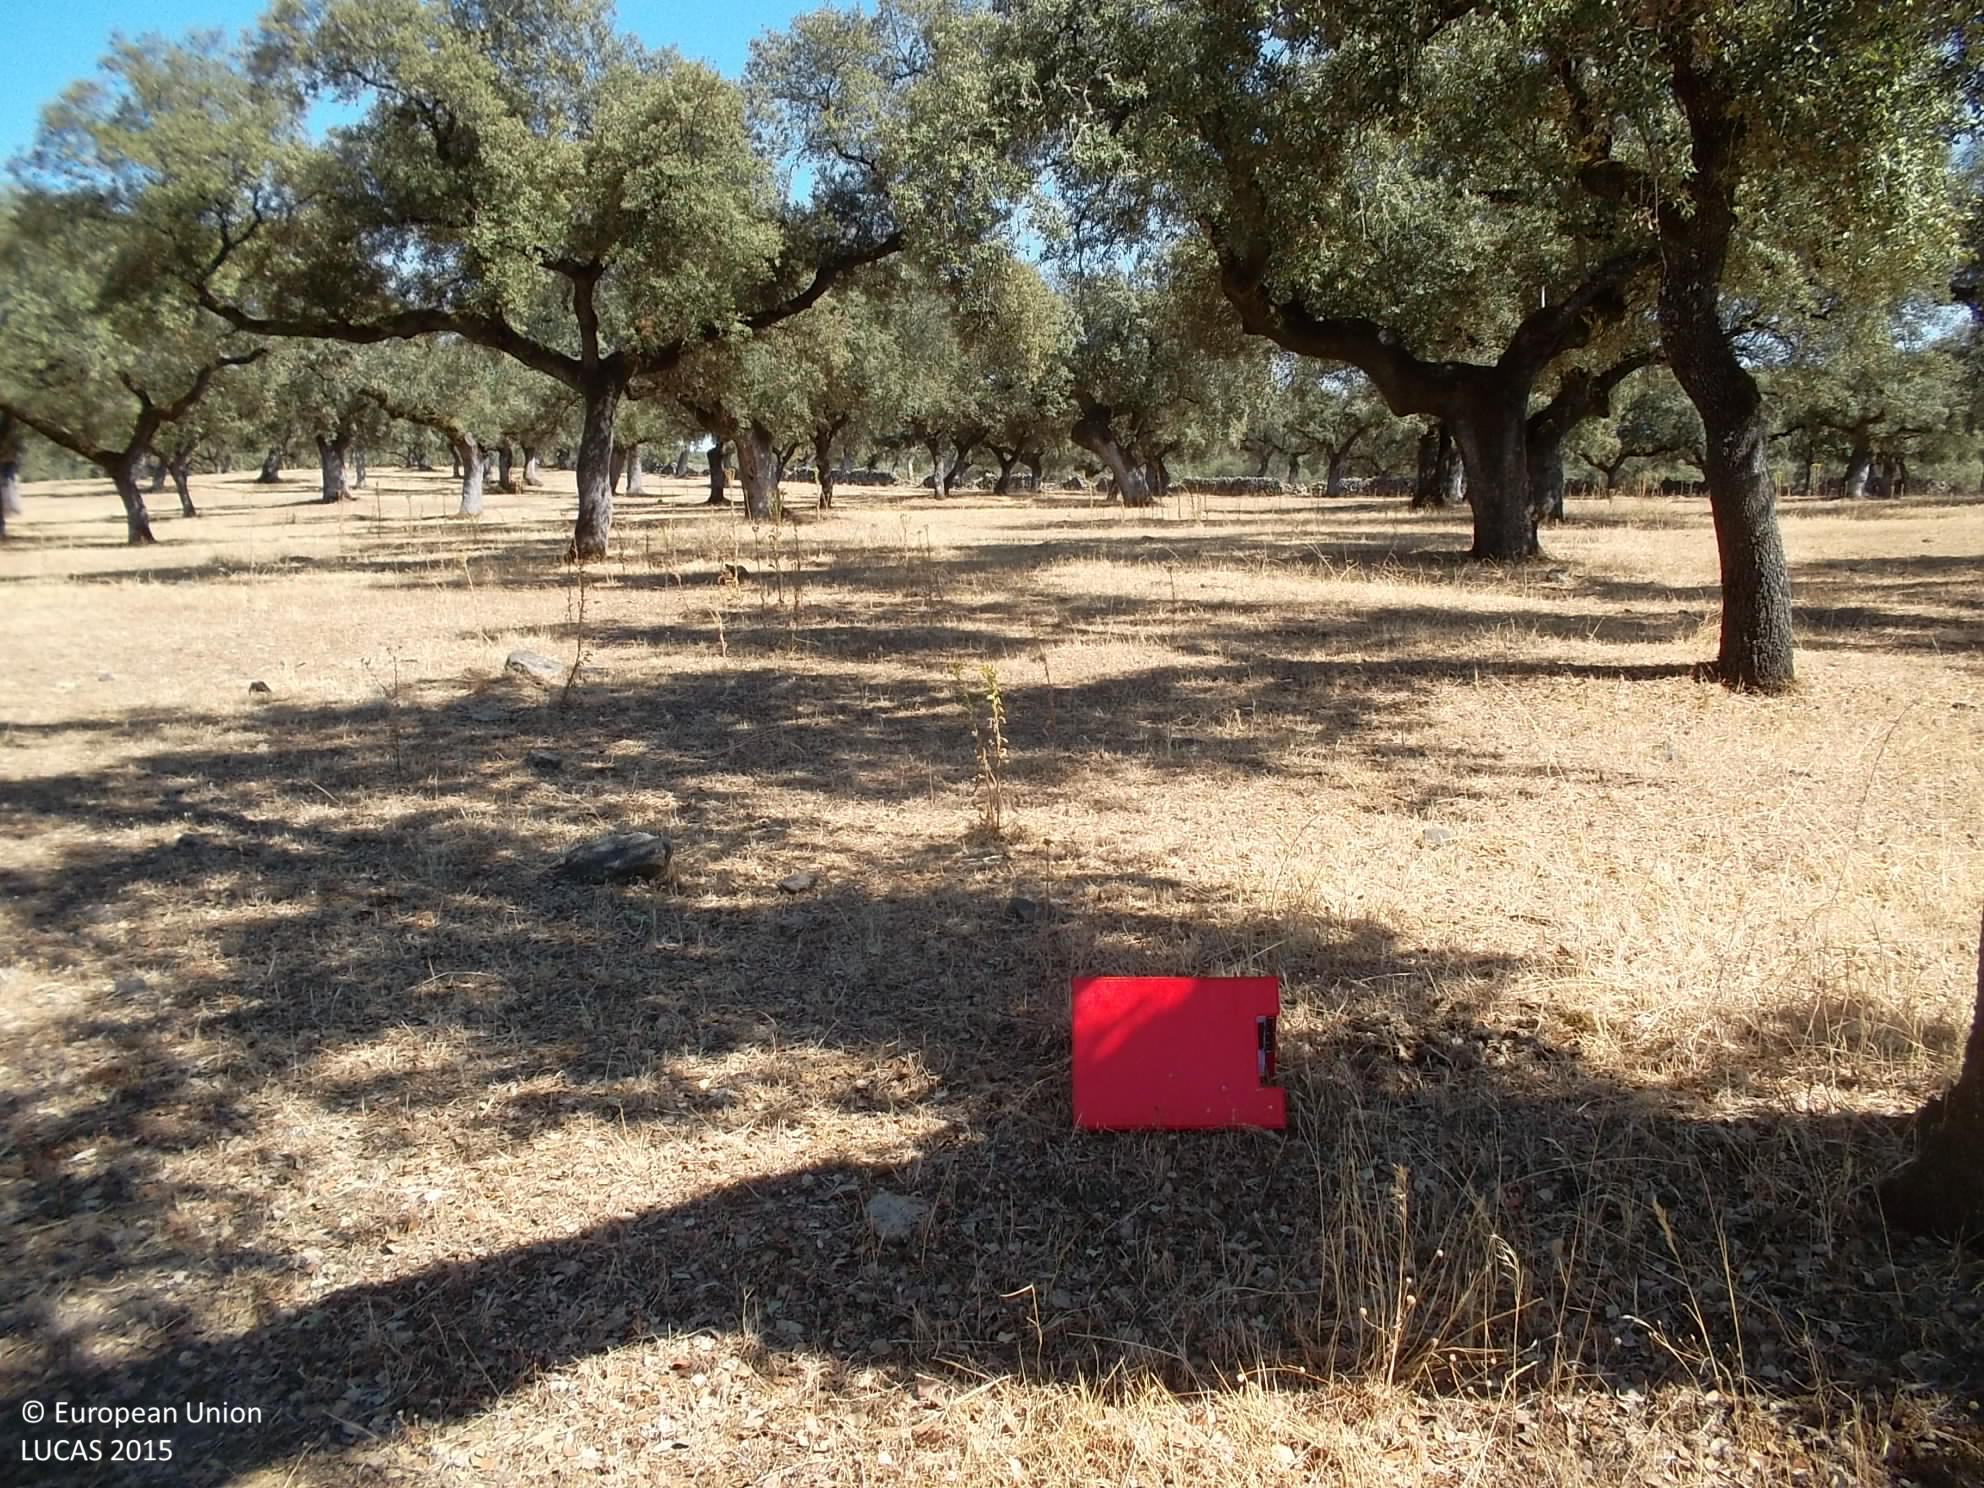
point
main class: Woodland
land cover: Broadleaved woodland
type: broadleaved evergreen forest
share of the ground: 50 - 75 %
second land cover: Grassland without tree/shrub cover
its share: 50 - 75 %
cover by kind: broadleaved forest trees 50 %, herbaceous plants 50 %
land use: Forestry
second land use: Agriculture (excluding fallow land and kitchen gardens)
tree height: > 5 m
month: August
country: ES
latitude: 38.4193
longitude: -6.6978
